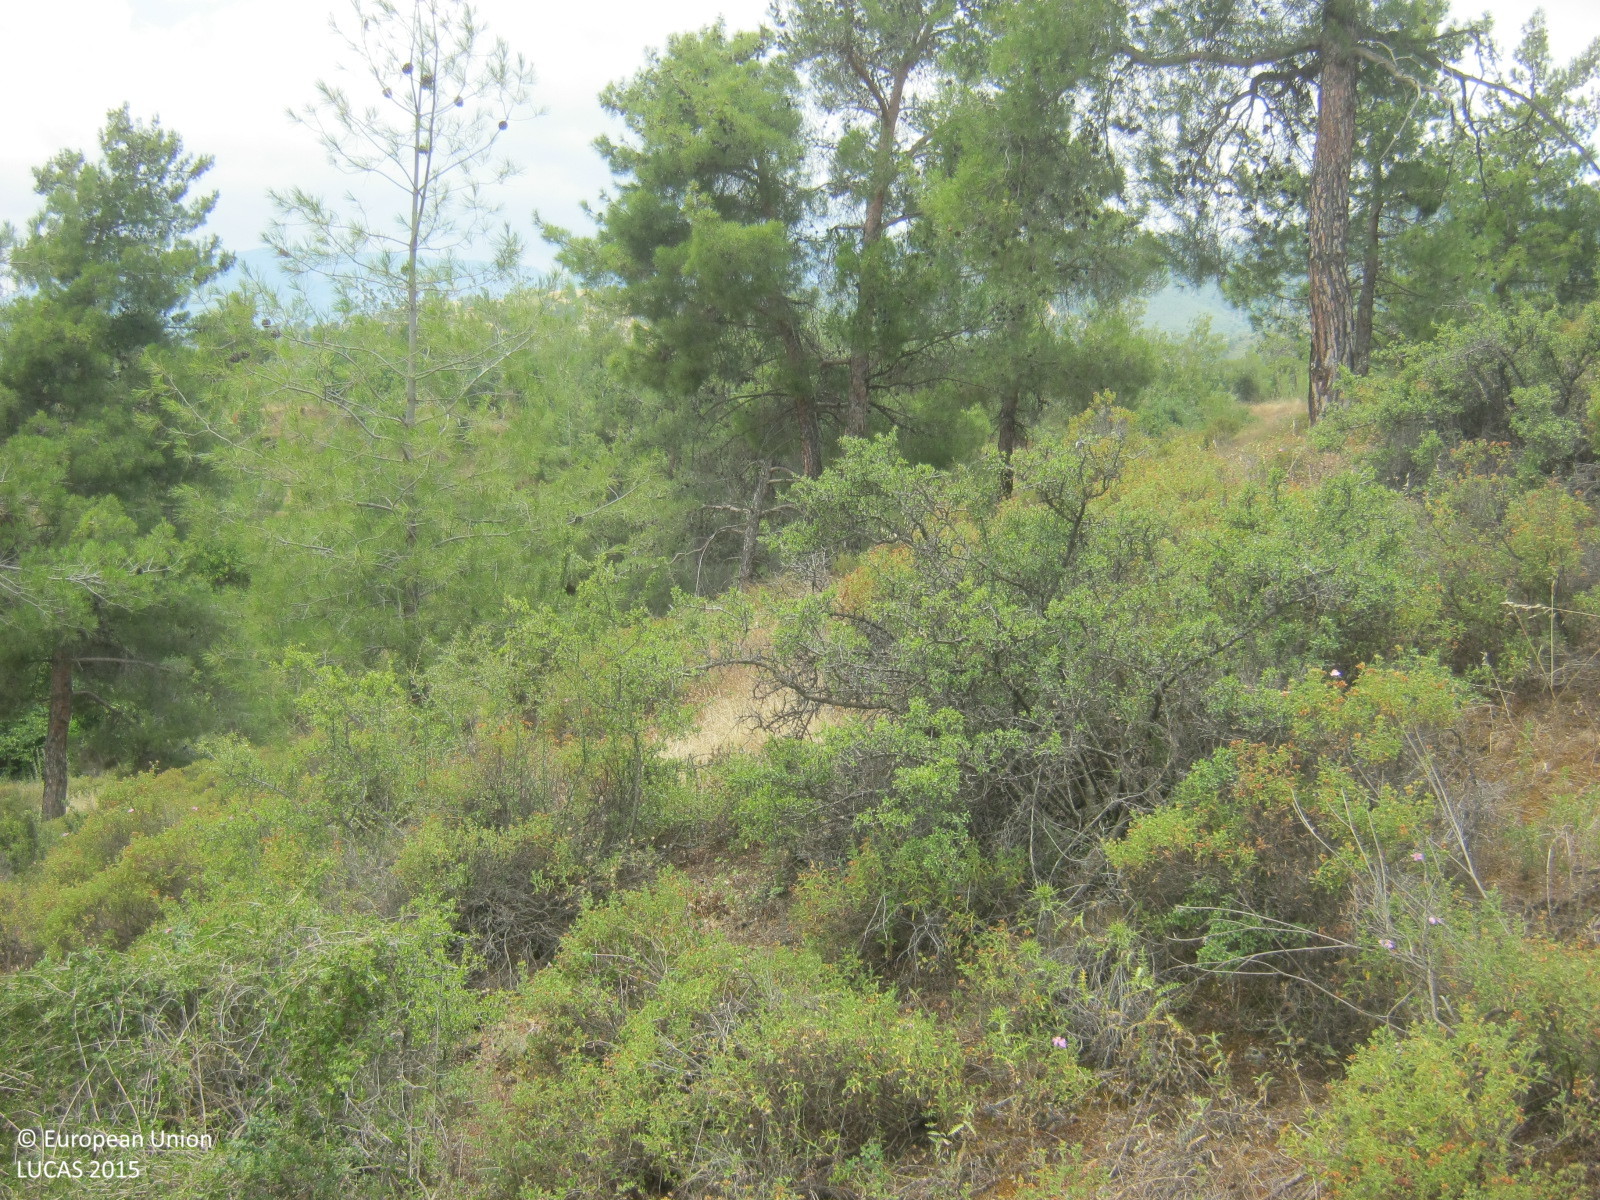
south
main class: Woodland
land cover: Pine dominated coniferous woodland
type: coniferous forest of the mediterranean region
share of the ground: 10 - 25 %
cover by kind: shrubs 40 %, herbaceous plants 30 %, coniferous forest trees 25 %, unconsolidated bare surface 5 %
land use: Forestry
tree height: > 5 m
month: June
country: CY
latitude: 35.0505
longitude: 32.8762
